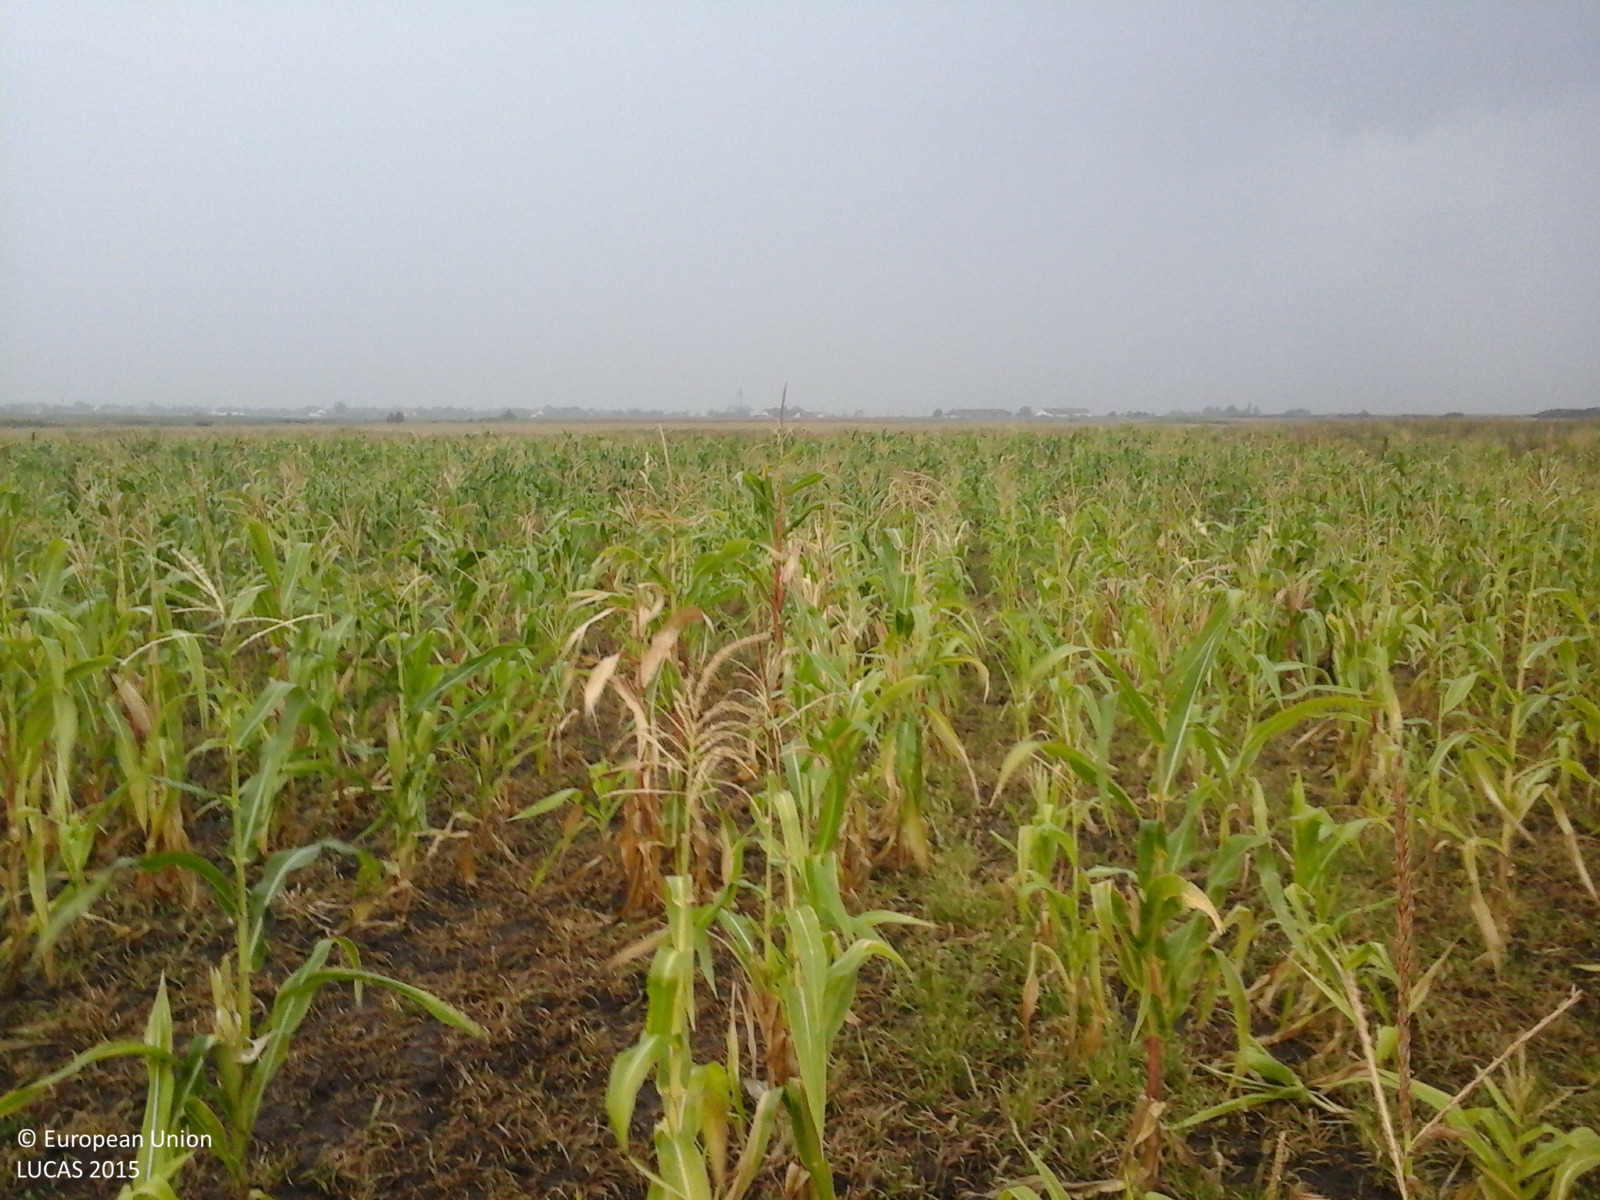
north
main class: Cropland
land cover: Maize
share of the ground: > 75 %
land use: Agriculture (excluding fallow land and kitchen gardens)
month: August
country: RO
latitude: 45.4848
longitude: 20.8876
